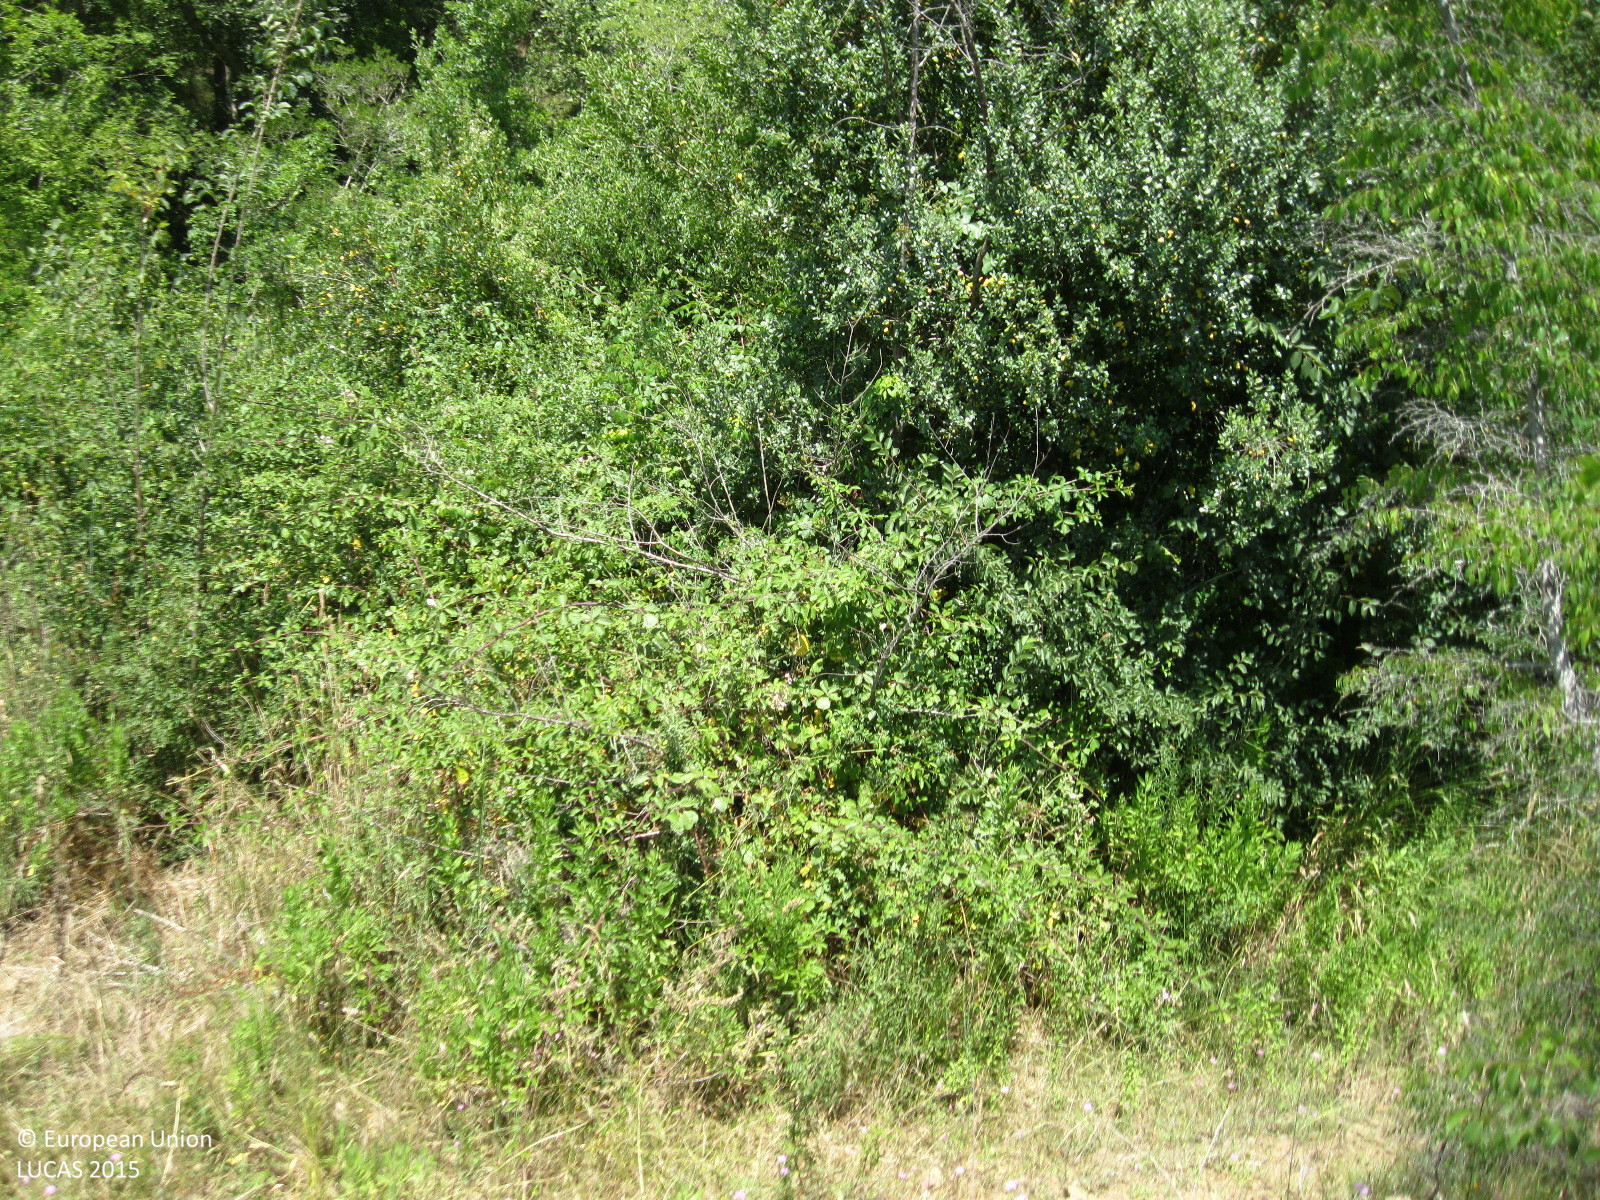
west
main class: Woodland
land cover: Broadleaved woodland
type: thermophilous deciduous forest
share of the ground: > 75 %
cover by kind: broadleaved forest trees 70 %, shrubs 25 %, herbaceous plants 5 %
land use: Forestry
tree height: > 5 m
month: July
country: IT
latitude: 42.6795
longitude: 11.4718
